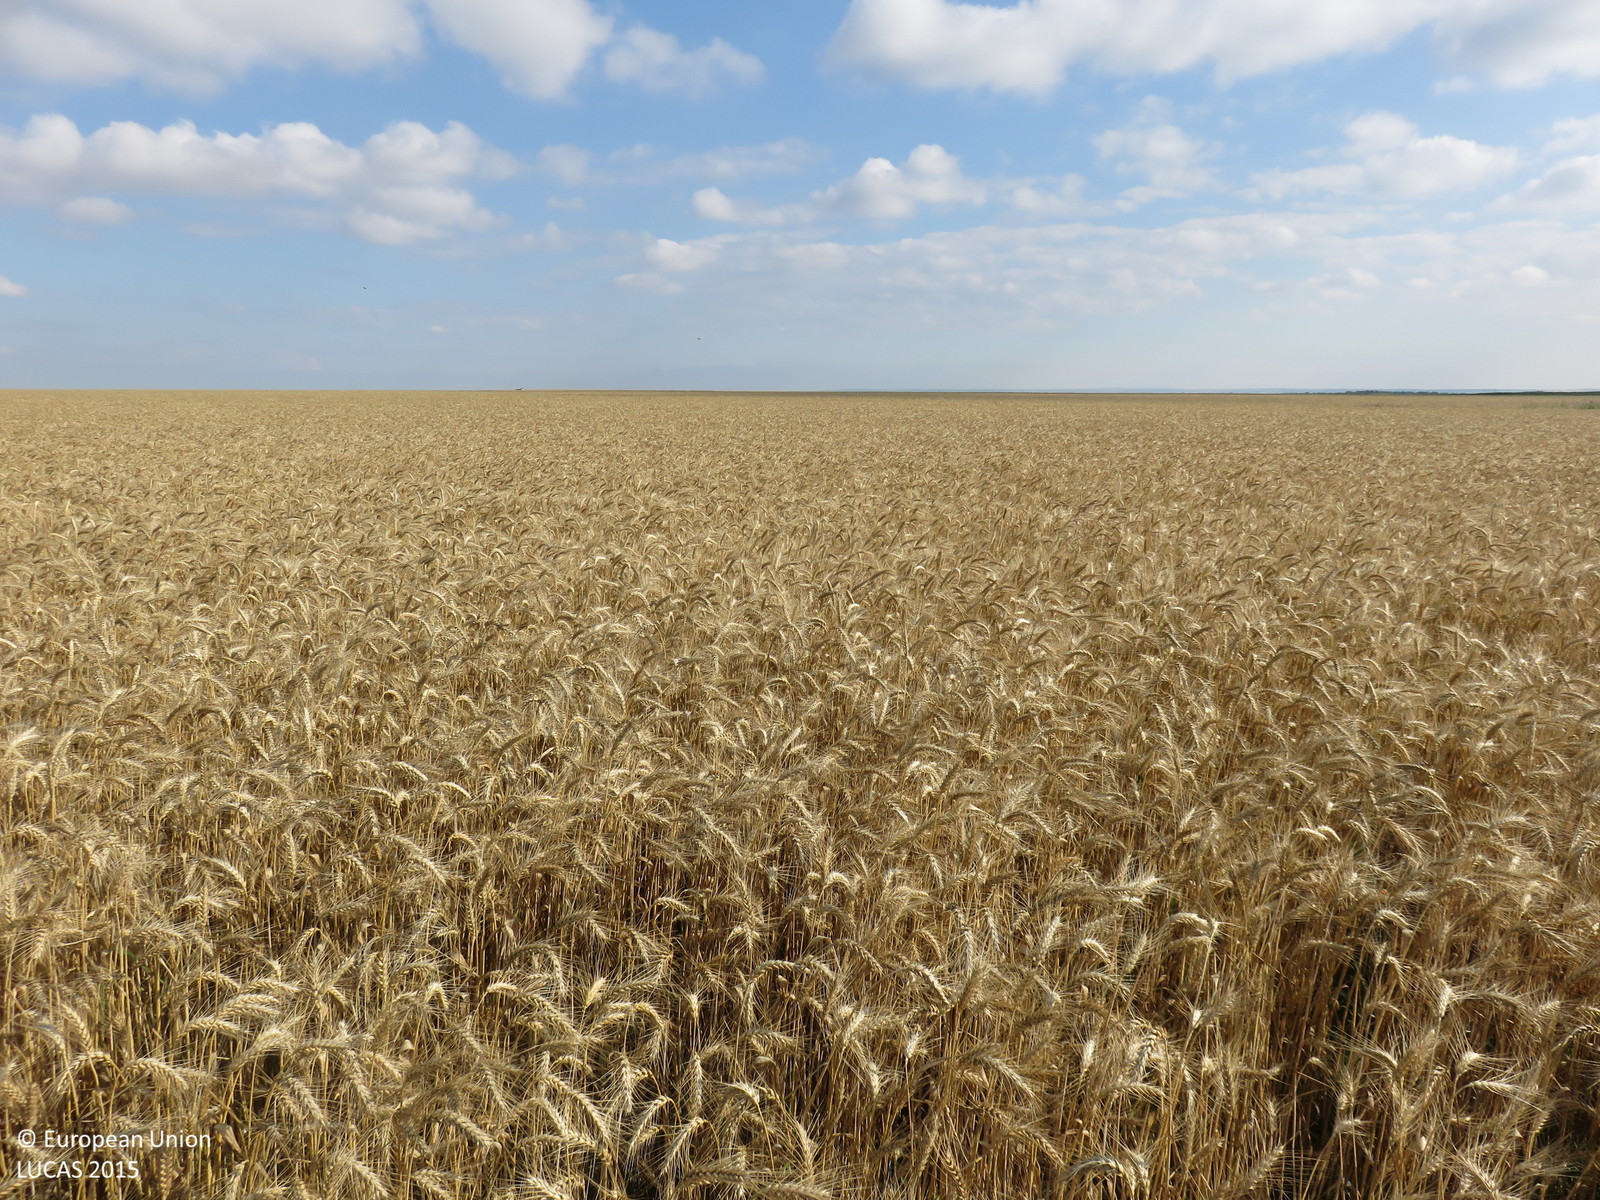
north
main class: Cropland
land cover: Common wheat
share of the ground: > 75 %
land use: Agriculture (excluding fallow land and kitchen gardens)
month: June
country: BG
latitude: 43.3292
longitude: 24.9793
